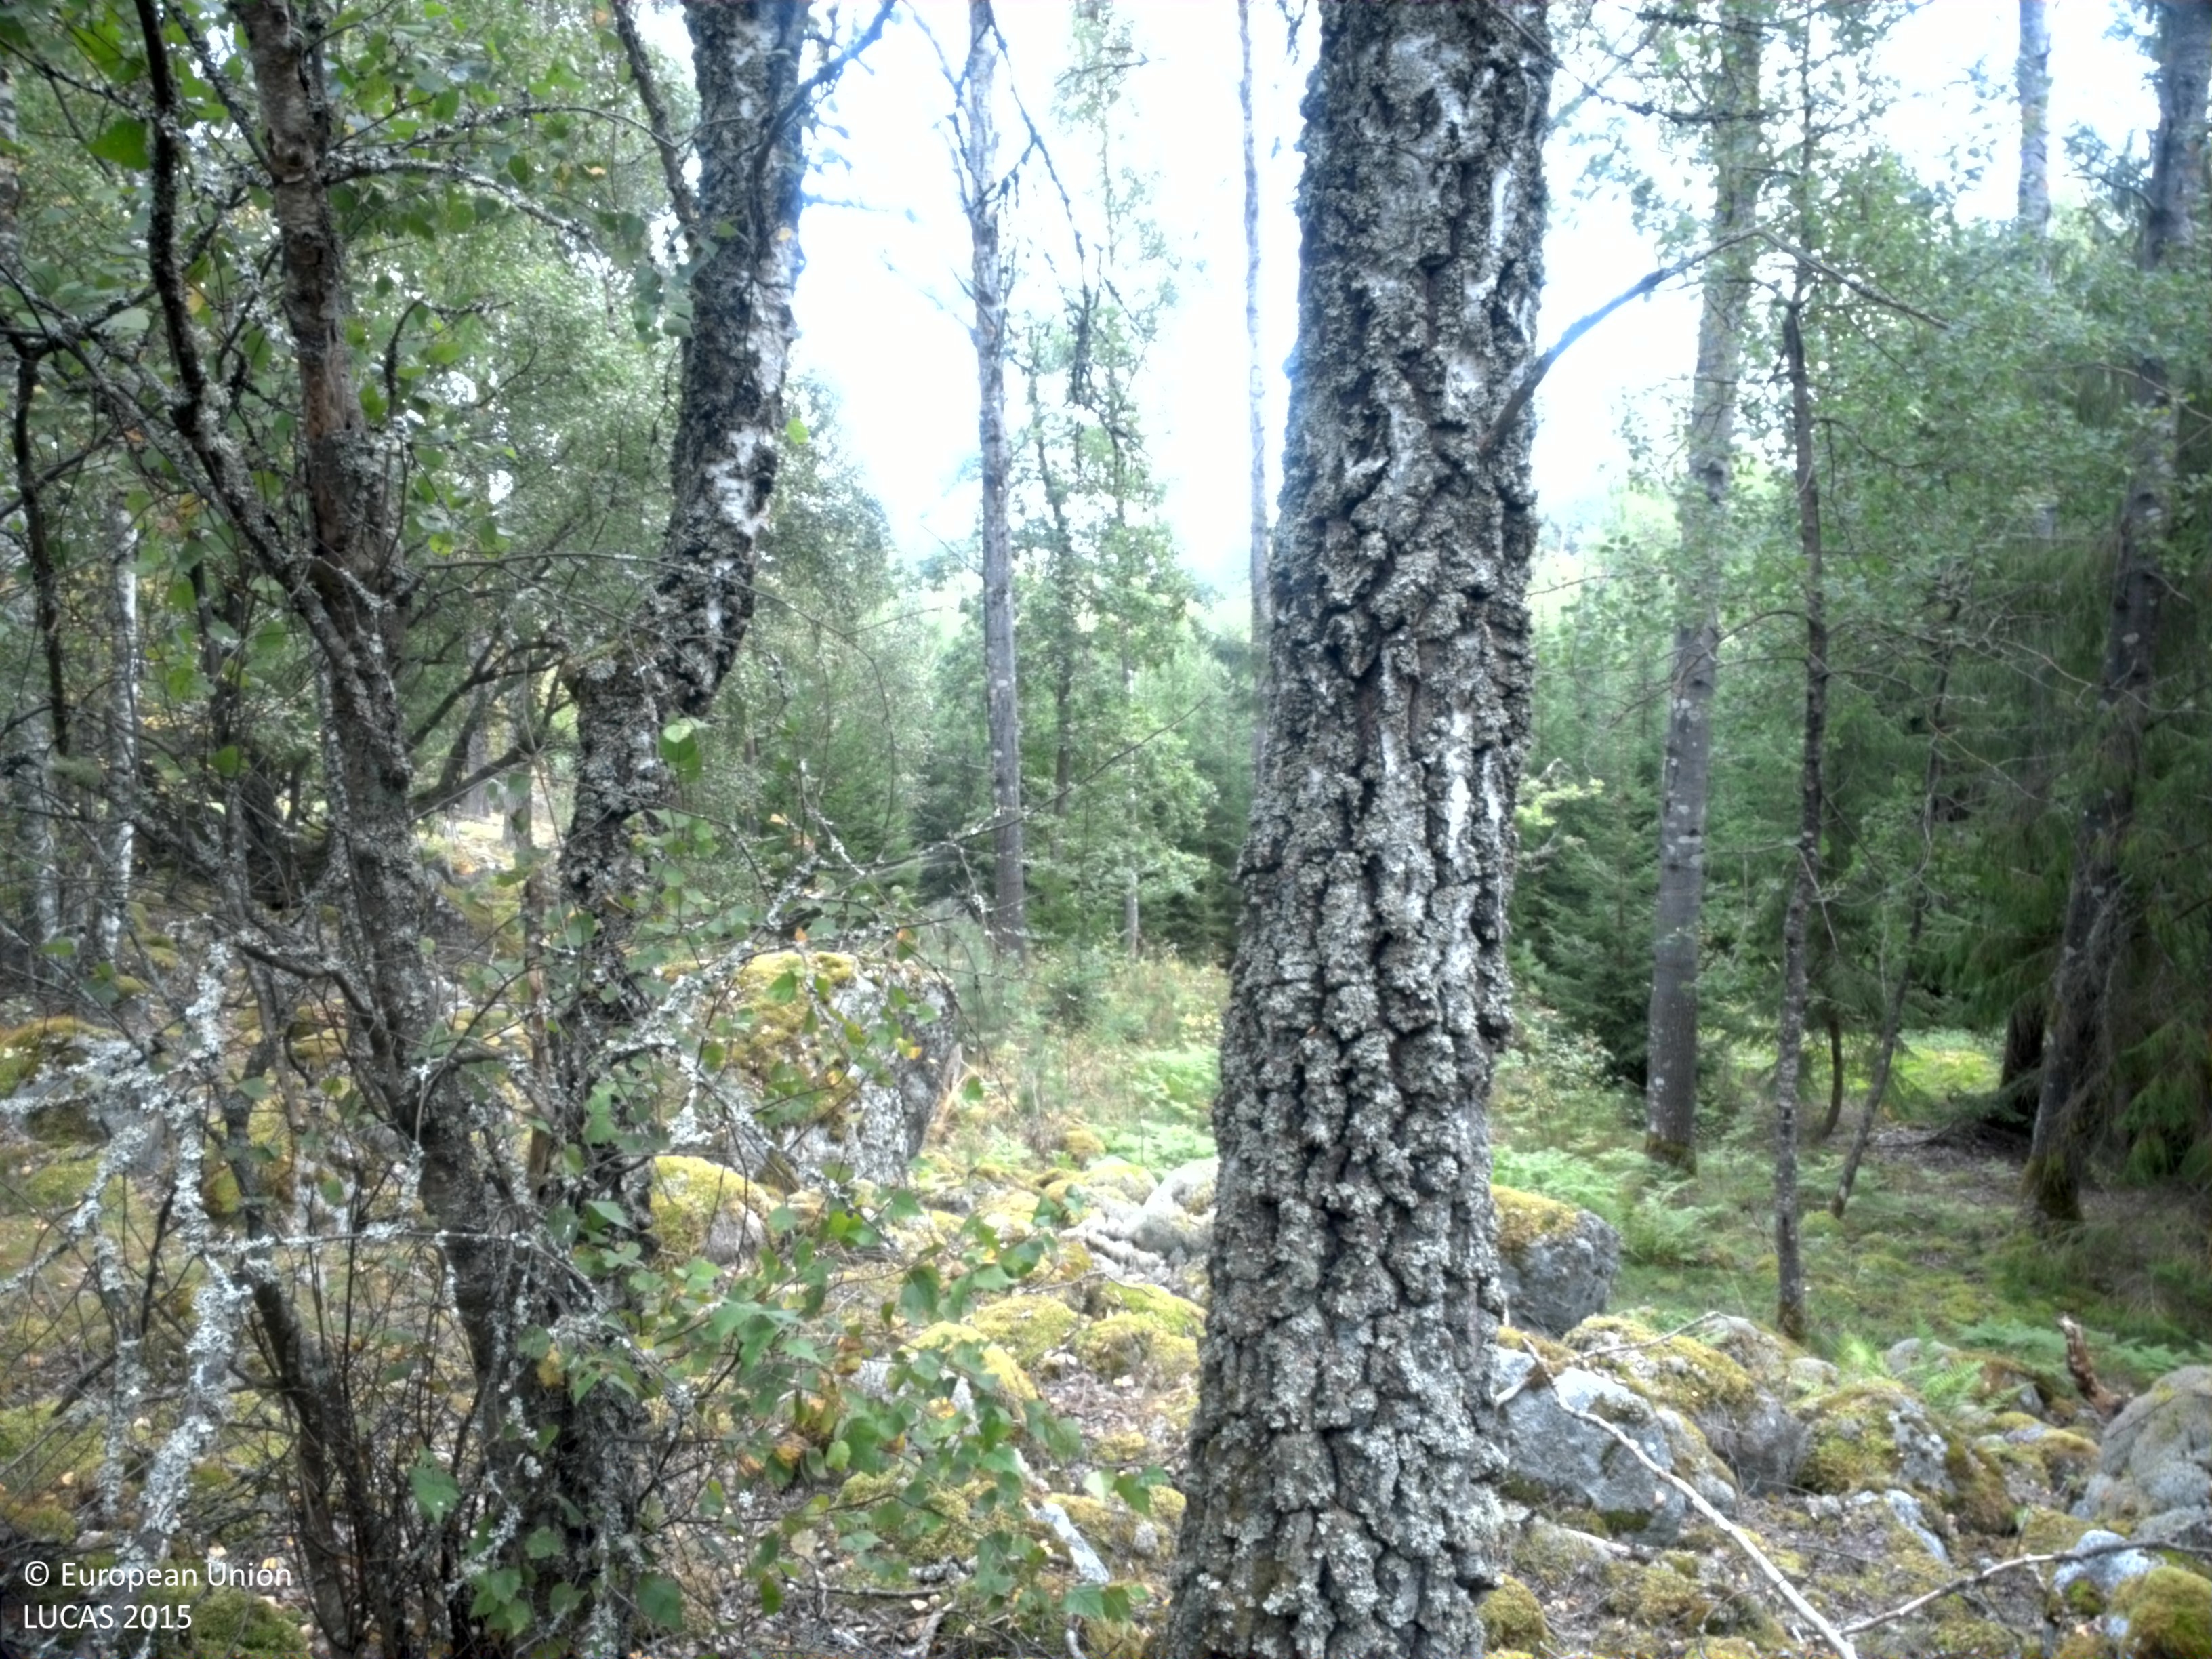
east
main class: Woodland
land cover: Spruce dominated mixed woodland
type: boreal forest
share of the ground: 50 - 75 %
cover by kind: lichens and mosses 35 %, coniferous forest trees 30 %, broadleaved forest trees 25 %, herbaceous plants 10 %
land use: Forestry
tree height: > 5 m
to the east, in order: Spruce dominated mixed woodland; Tracks; Spruce dominated mixed woodland; Spruce dominated coniferous woodland
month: August
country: SE
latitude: 59.5271
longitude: 17.1894
